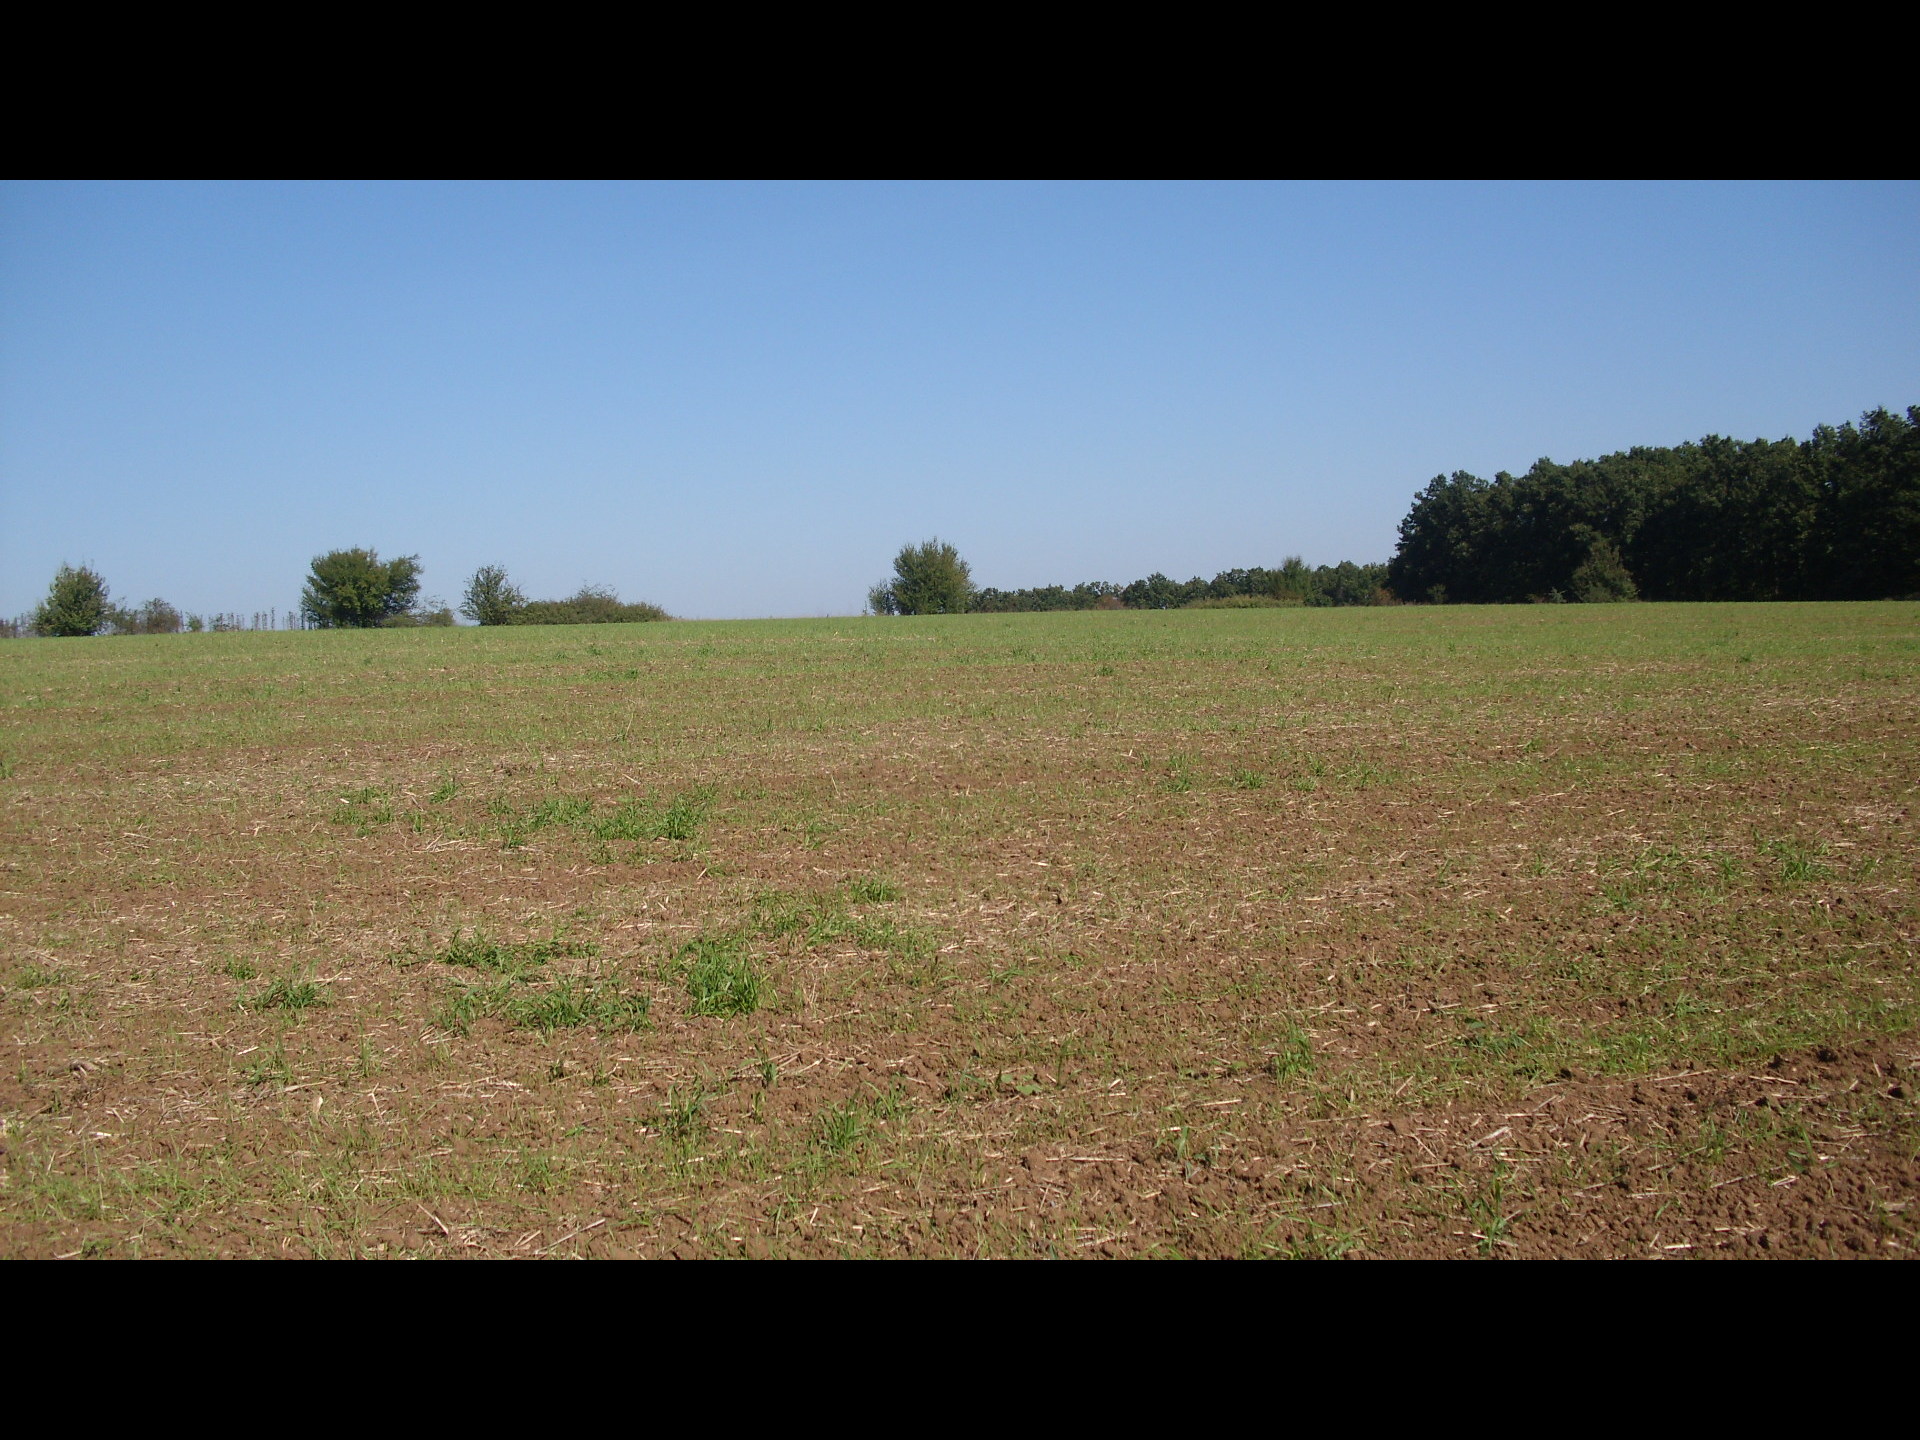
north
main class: Cropland
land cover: Common wheat
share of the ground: < 10 %
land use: Agriculture (excluding fallow land and kitchen gardens)
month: October
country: BG
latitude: 43.8538
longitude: 22.7381
